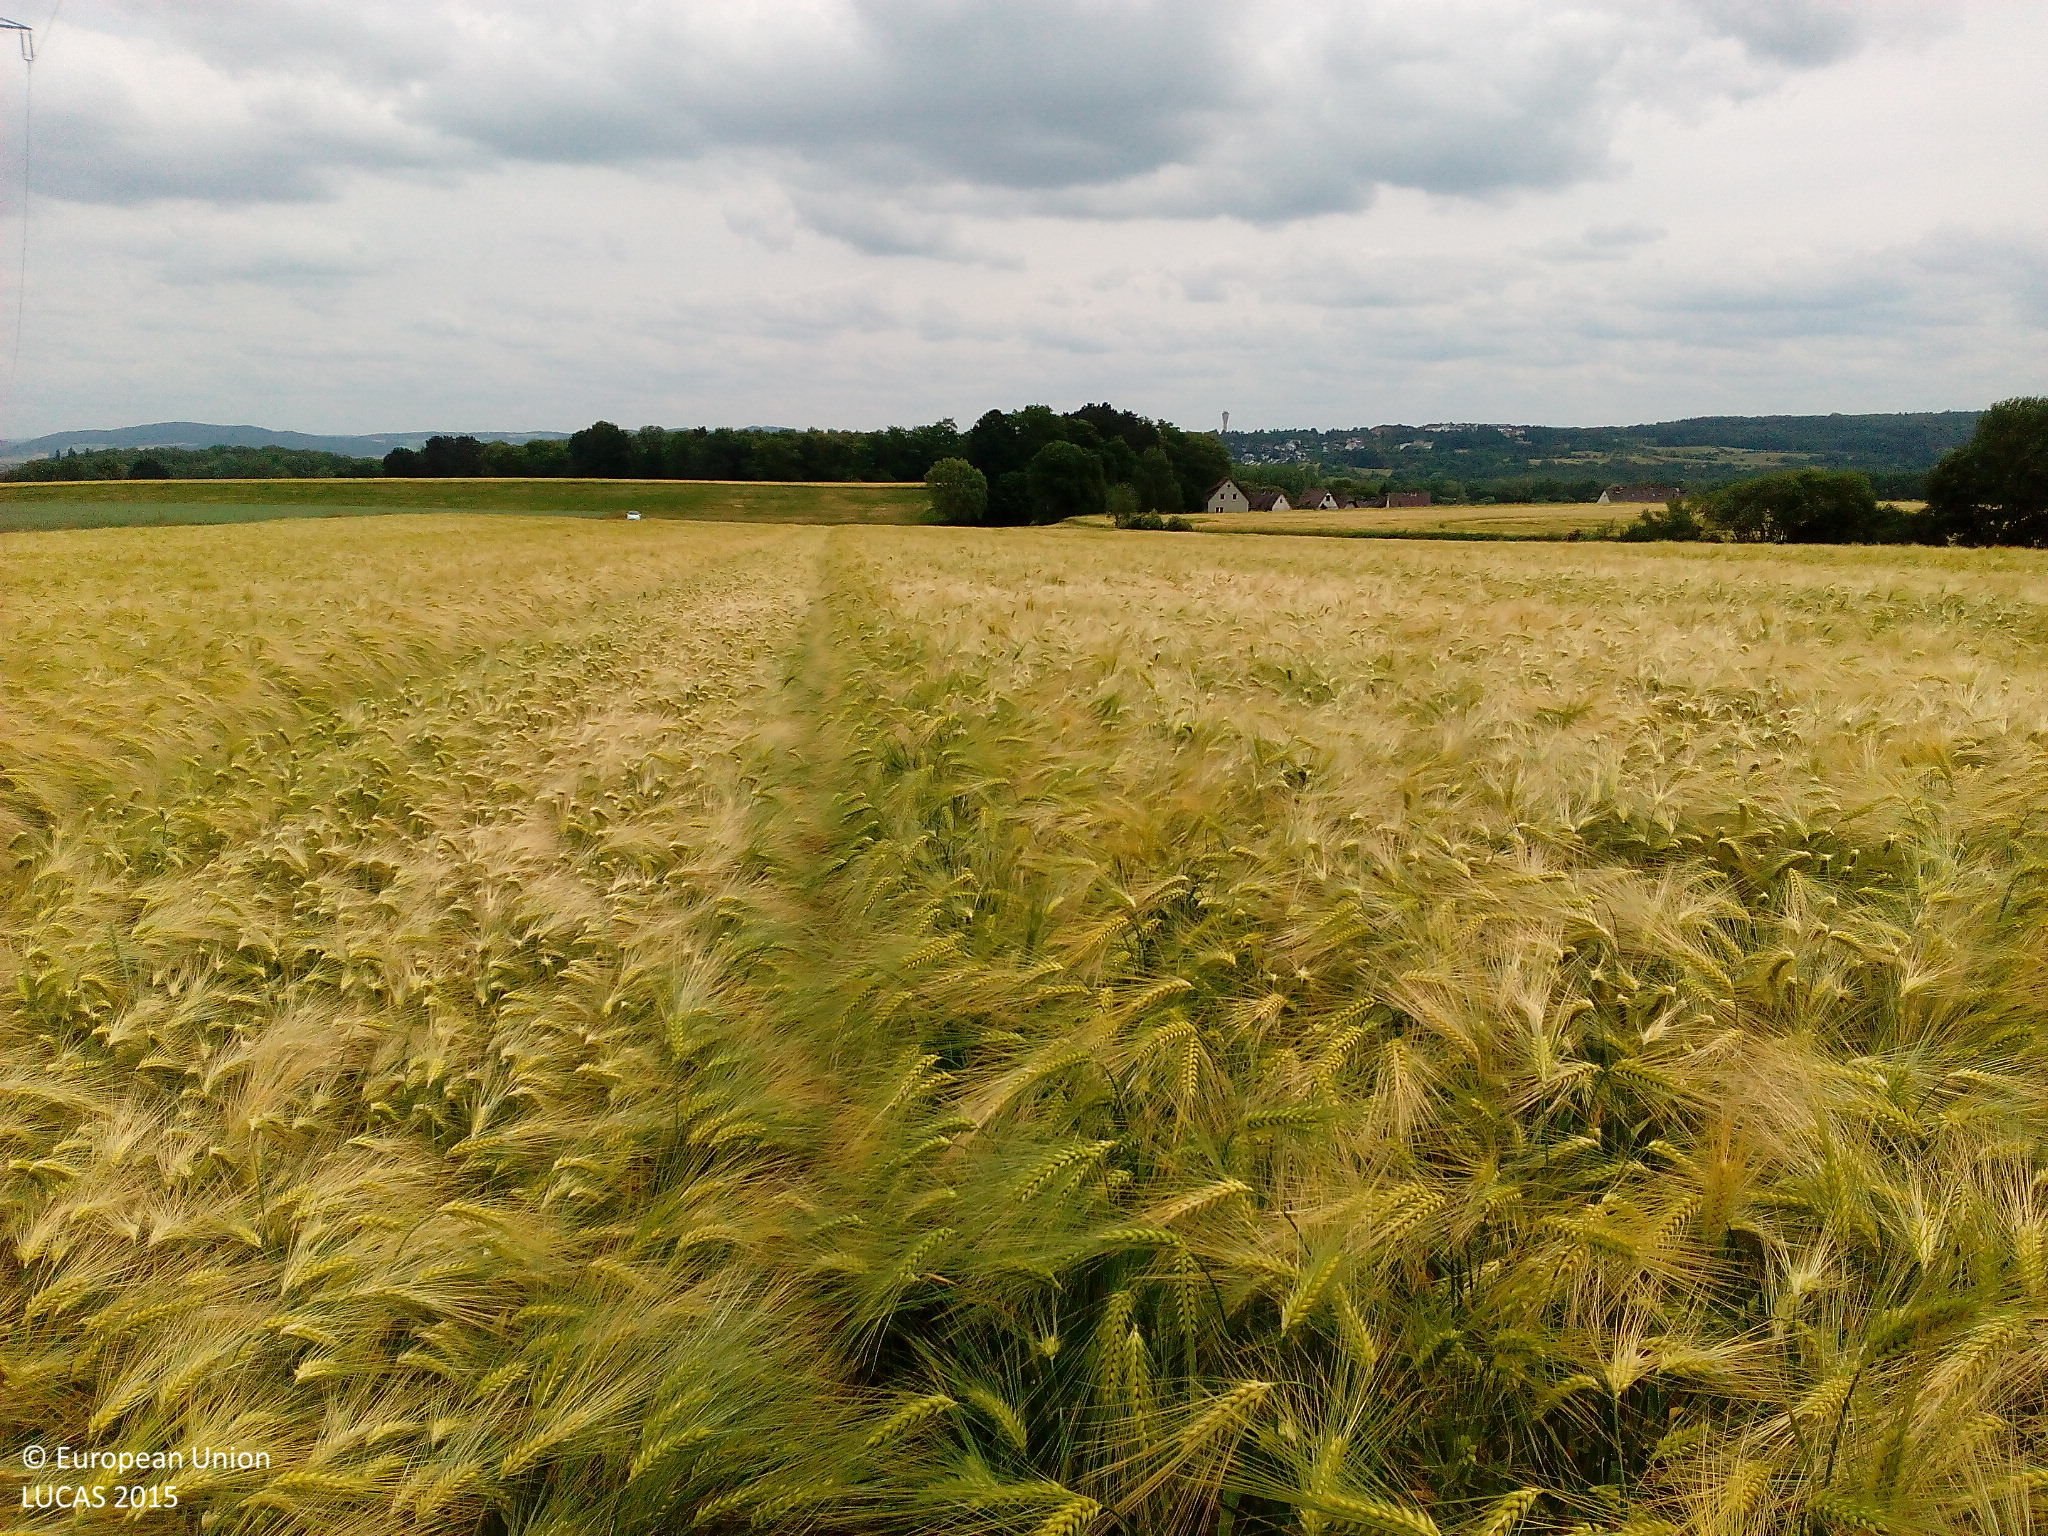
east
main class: Artificial land
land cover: Other artificial areas
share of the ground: > 75 %
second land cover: Barley
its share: > 75 %
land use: Electricity, gas and thermal power distribution
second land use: Agriculture (excluding fallow land and kitchen gardens)
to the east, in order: Artificial constructions in urban areas; Barley; Grass margins; Tracks; Grassland without tree/shrub cover
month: June
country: DE
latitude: 51.0448
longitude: 9.2443
